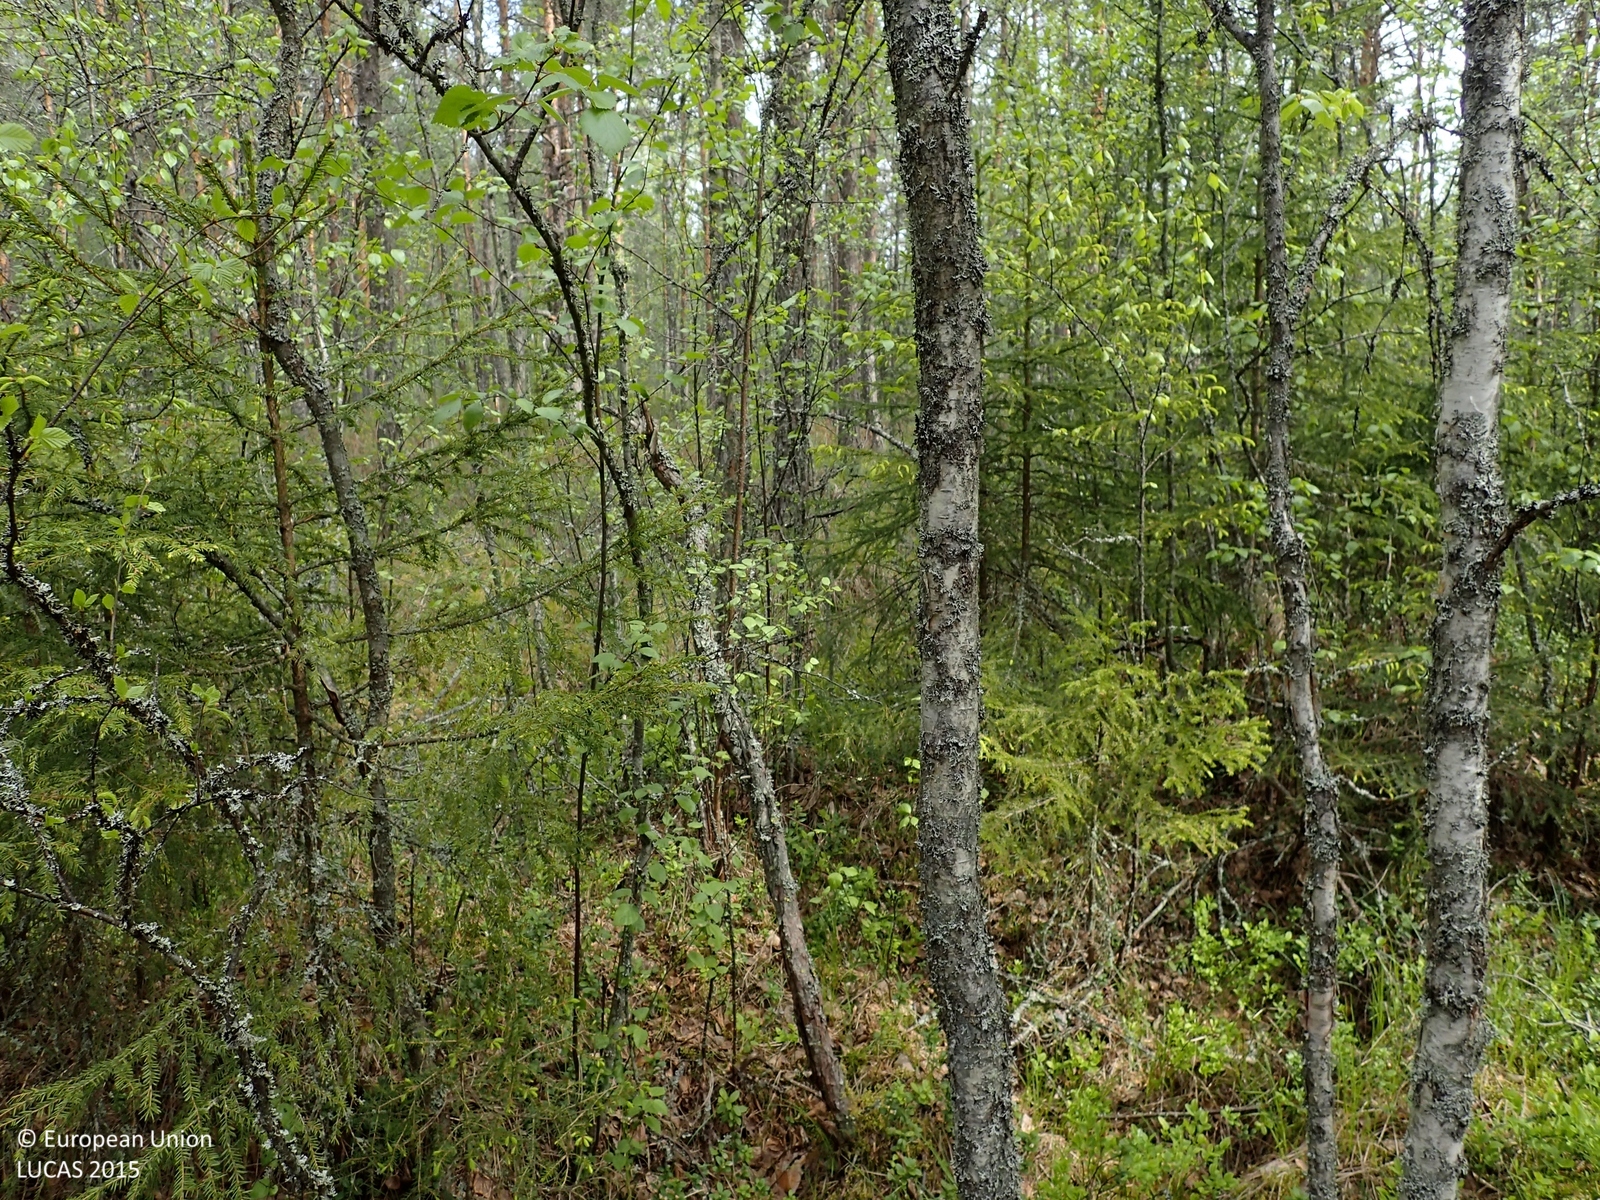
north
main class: Woodland
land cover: Pine dominated mixed woodland
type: boreal forest
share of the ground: > 75 %
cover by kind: coniferous forest trees 65 %, broadleaved forest trees 25 %, shrubs 10 %
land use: Forestry
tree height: > 5 m
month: June
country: FI
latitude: 62.2435
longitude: 21.7311
